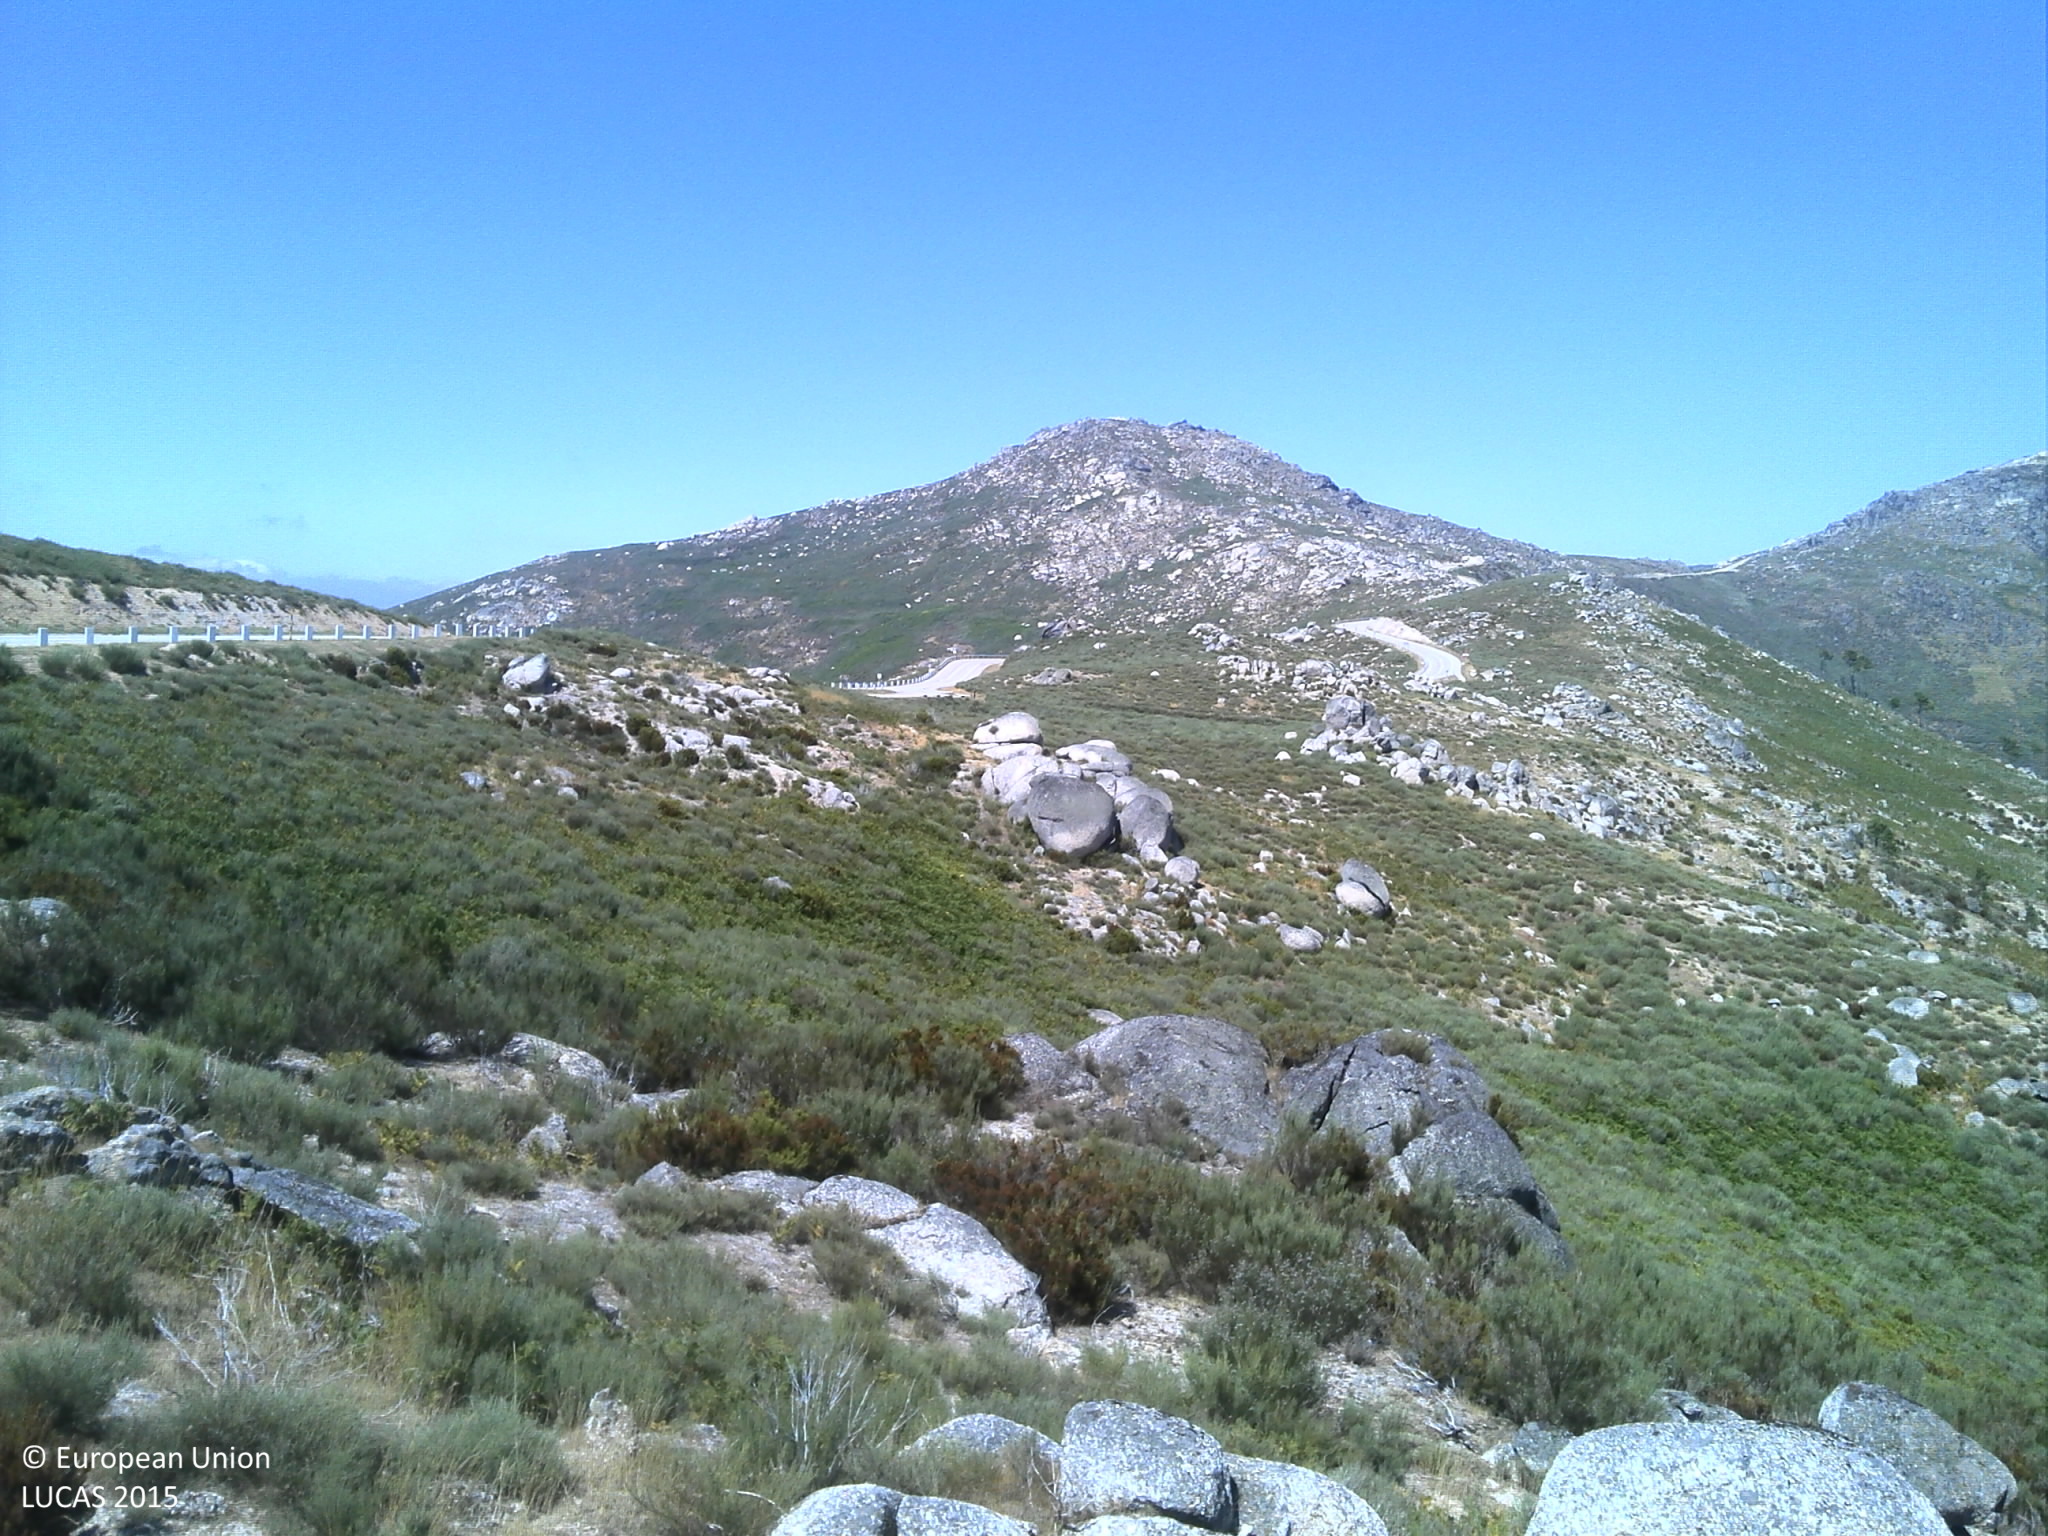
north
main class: Shrubland
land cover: Shrubland without tree cover
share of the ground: 50 - 75 %
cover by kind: shrubs 60 %, unconsolidated bare surface 30 %, herbaceous plants 10 %
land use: Semi-natural and natural areas not in use
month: July
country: PT
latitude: 40.3442
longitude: -7.6896
